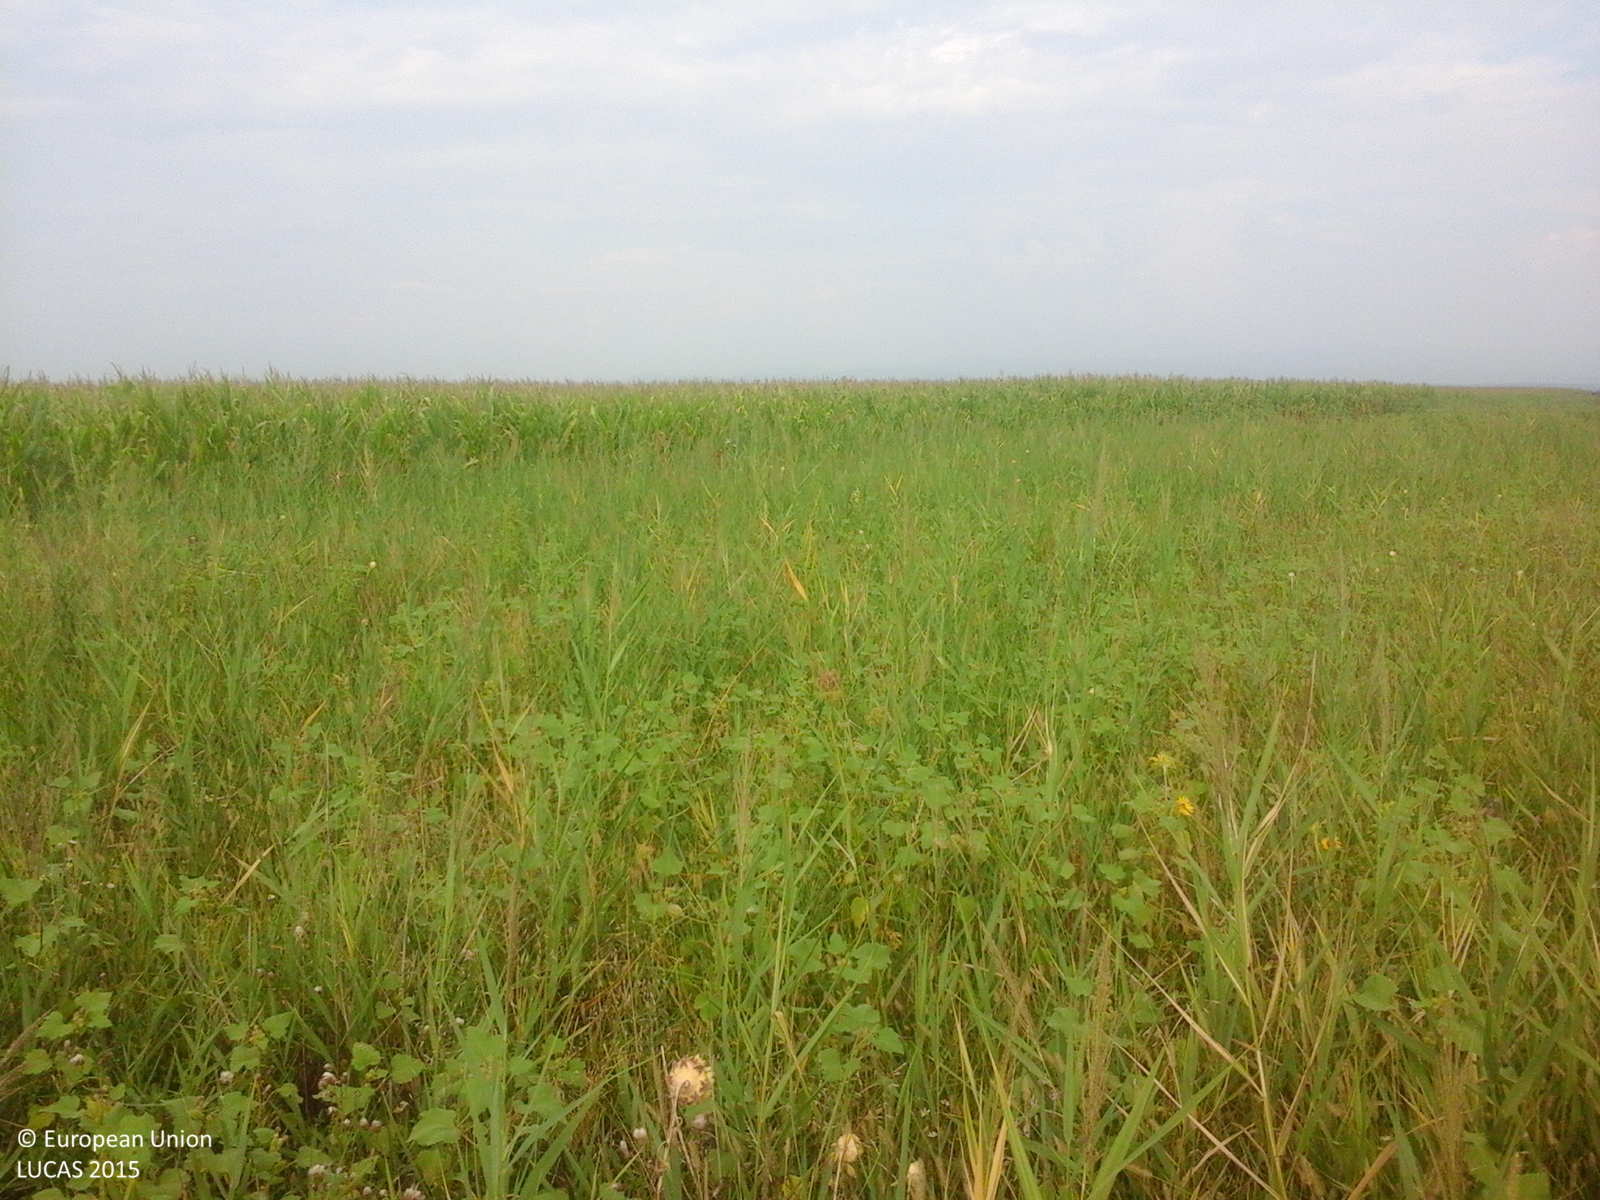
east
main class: Grassland
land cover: Spontaneously vegetated surfaces
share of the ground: > 75 %
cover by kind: herbaceous plants 100 %
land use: Agriculture (excluding fallow land and kitchen gardens)
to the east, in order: Spontaneously vegetated surfaces; Maize
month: August
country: RO
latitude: 46.5514
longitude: 21.7931
